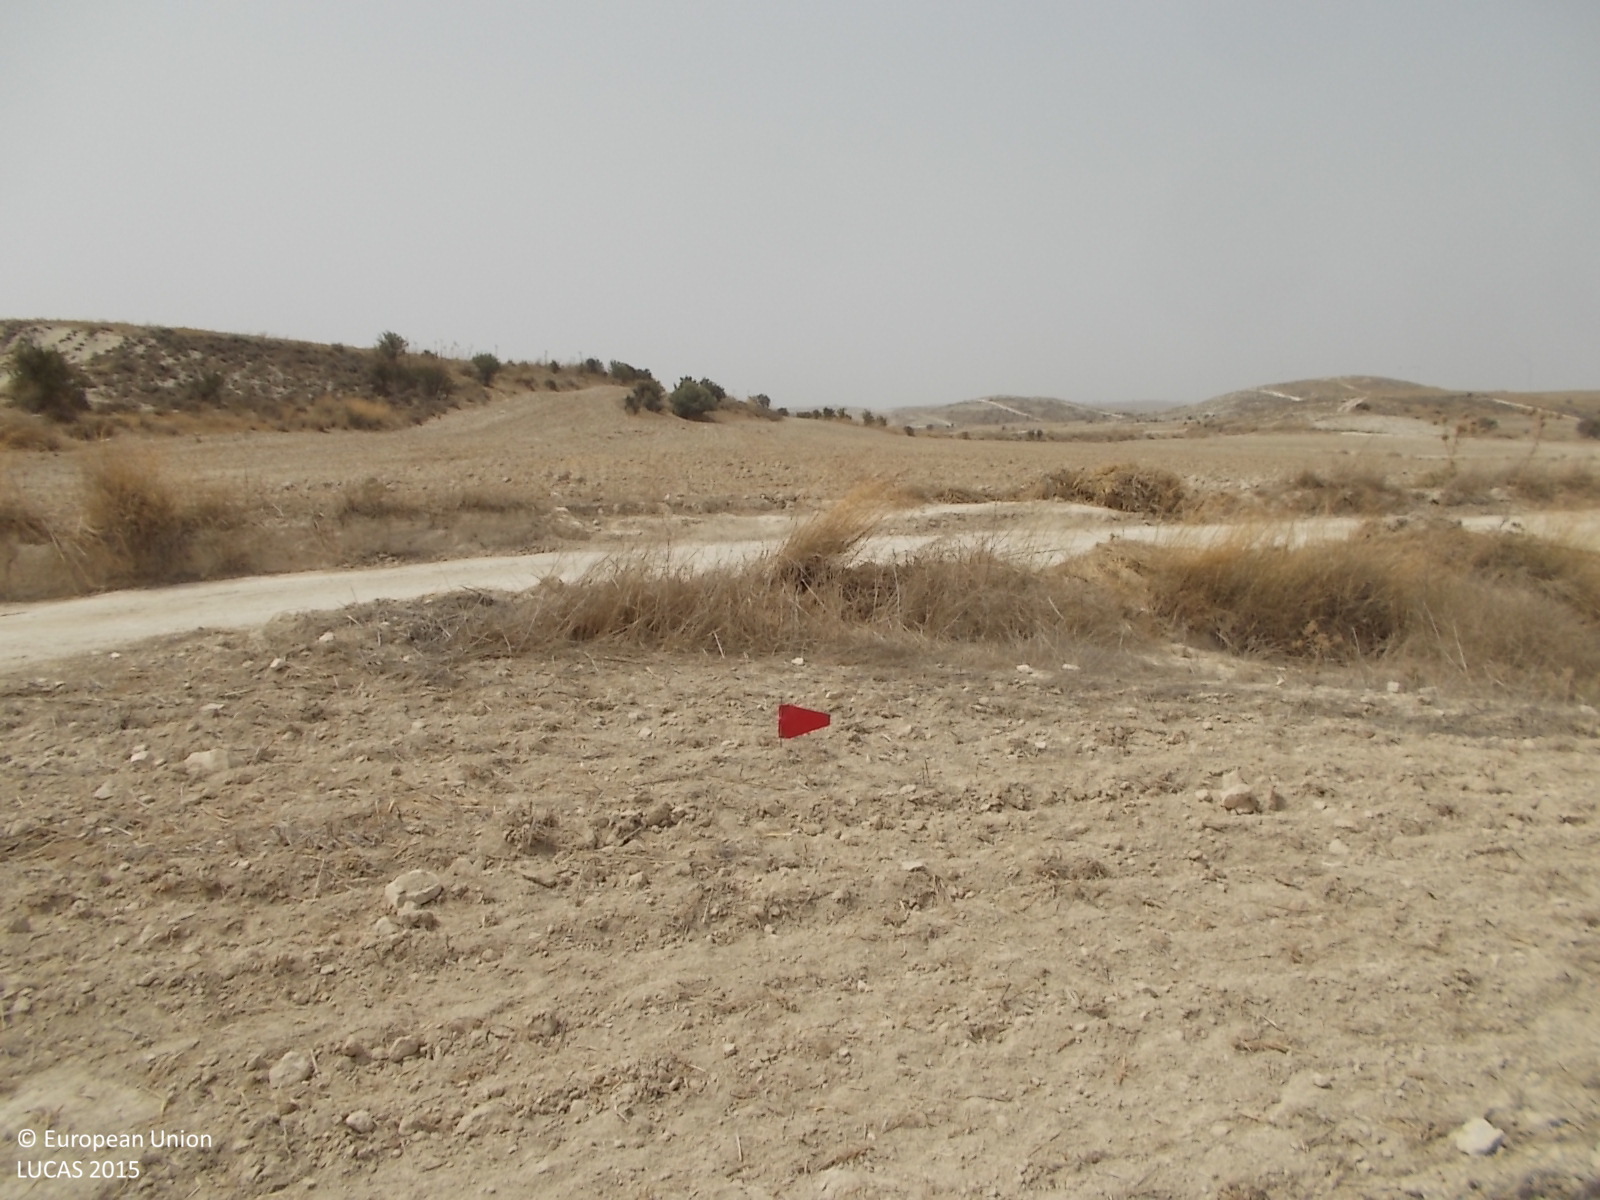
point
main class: Cropland
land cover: Mixed cereals for fodder
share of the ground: < 10 %
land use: Agriculture (excluding fallow land and kitchen gardens)
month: April
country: CY
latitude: 34.9052
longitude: 33.5132
